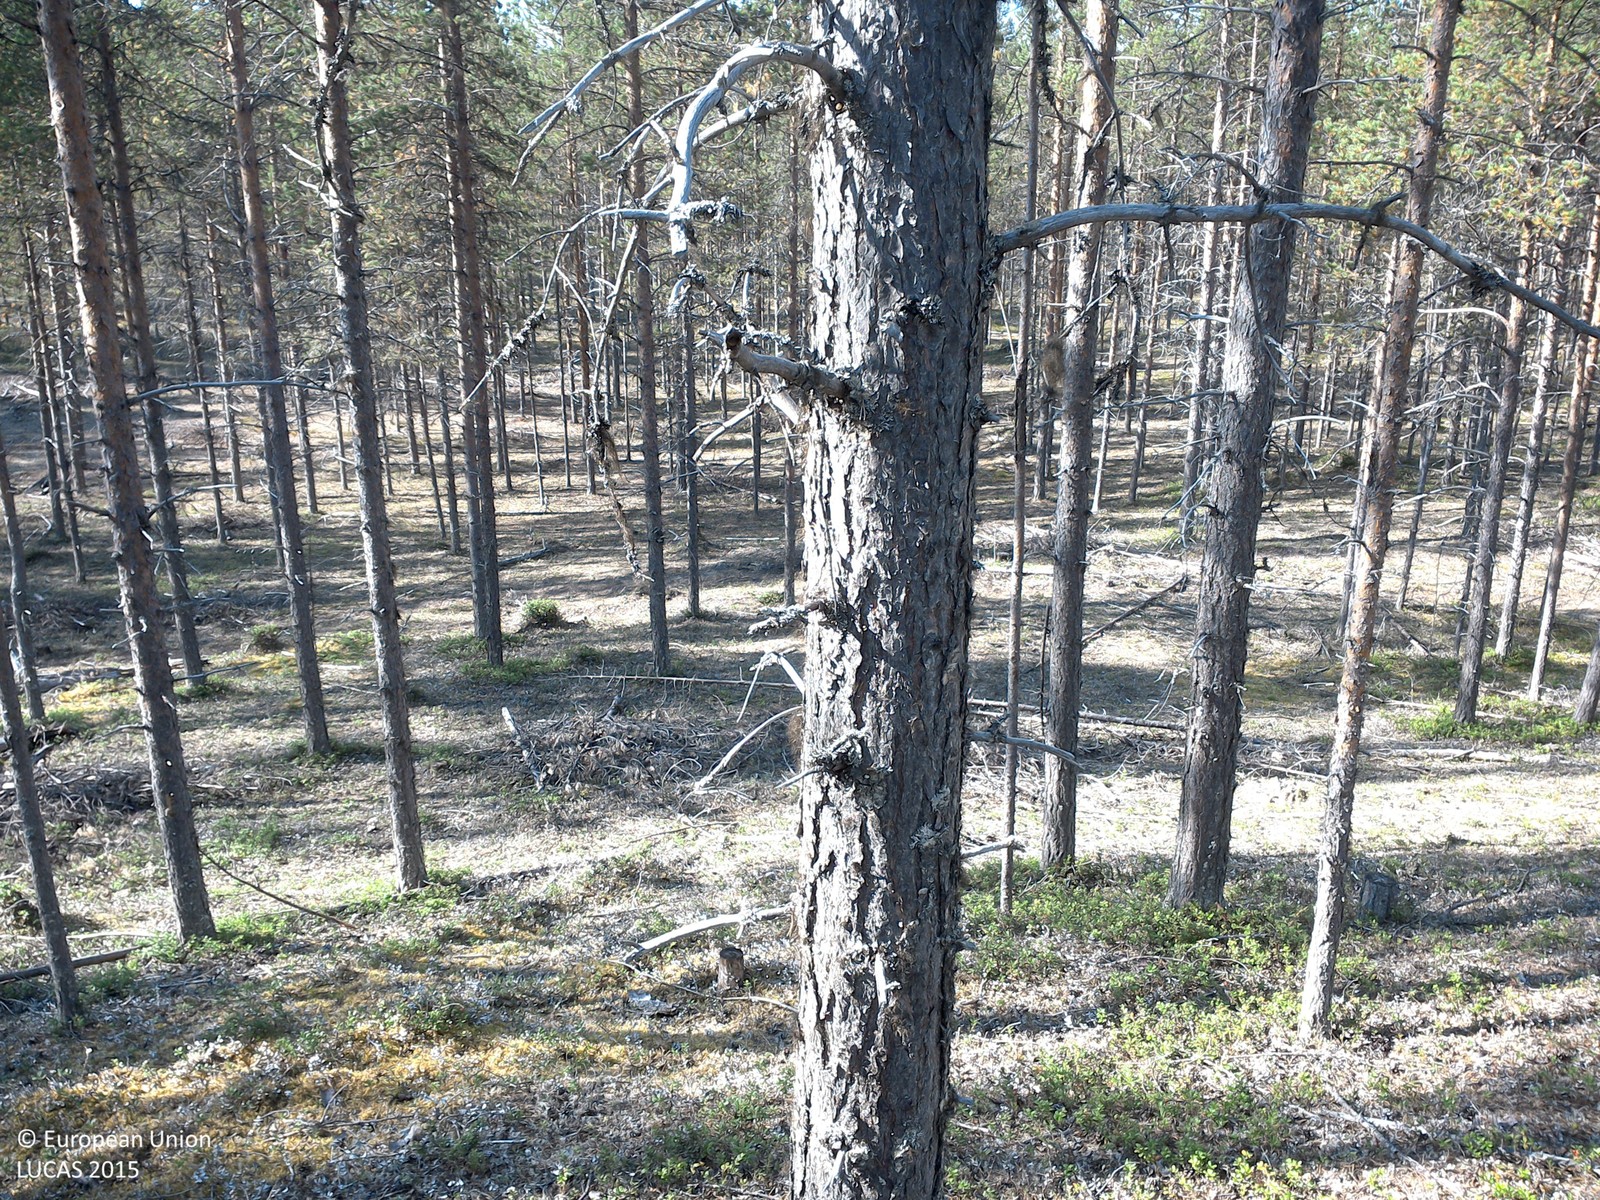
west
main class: Woodland
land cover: Pine dominated coniferous woodland
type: boreal forest
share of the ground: 25 - 50 %
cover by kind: lichens and mosses 45 %, coniferous forest trees 30 %, shrubs 25 %
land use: Forestry
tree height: > 5 m
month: August
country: SE
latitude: 67.3765
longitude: 22.1867
